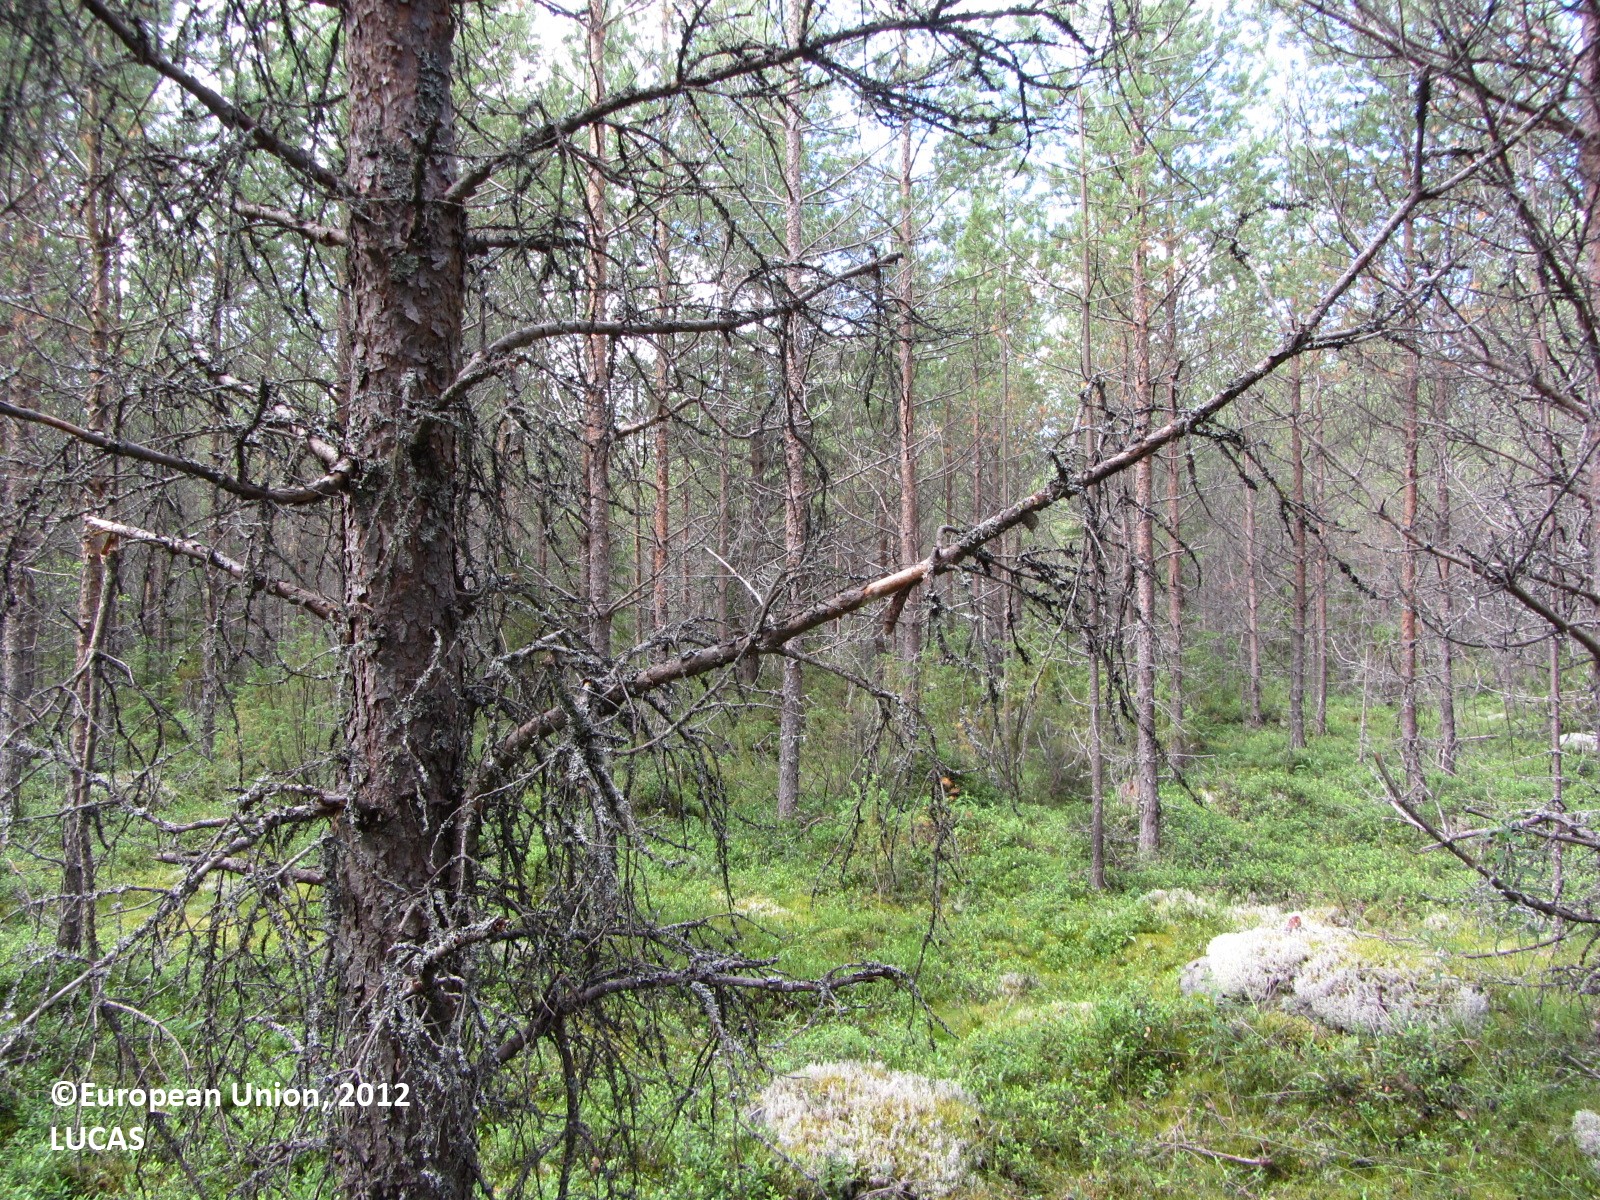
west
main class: Woodland
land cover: Pine dominated coniferous woodland
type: boreal forest
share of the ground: > 75 %
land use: Forestry
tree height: > 5 m
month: July
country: FI
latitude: 63.6029
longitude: 25.3997
